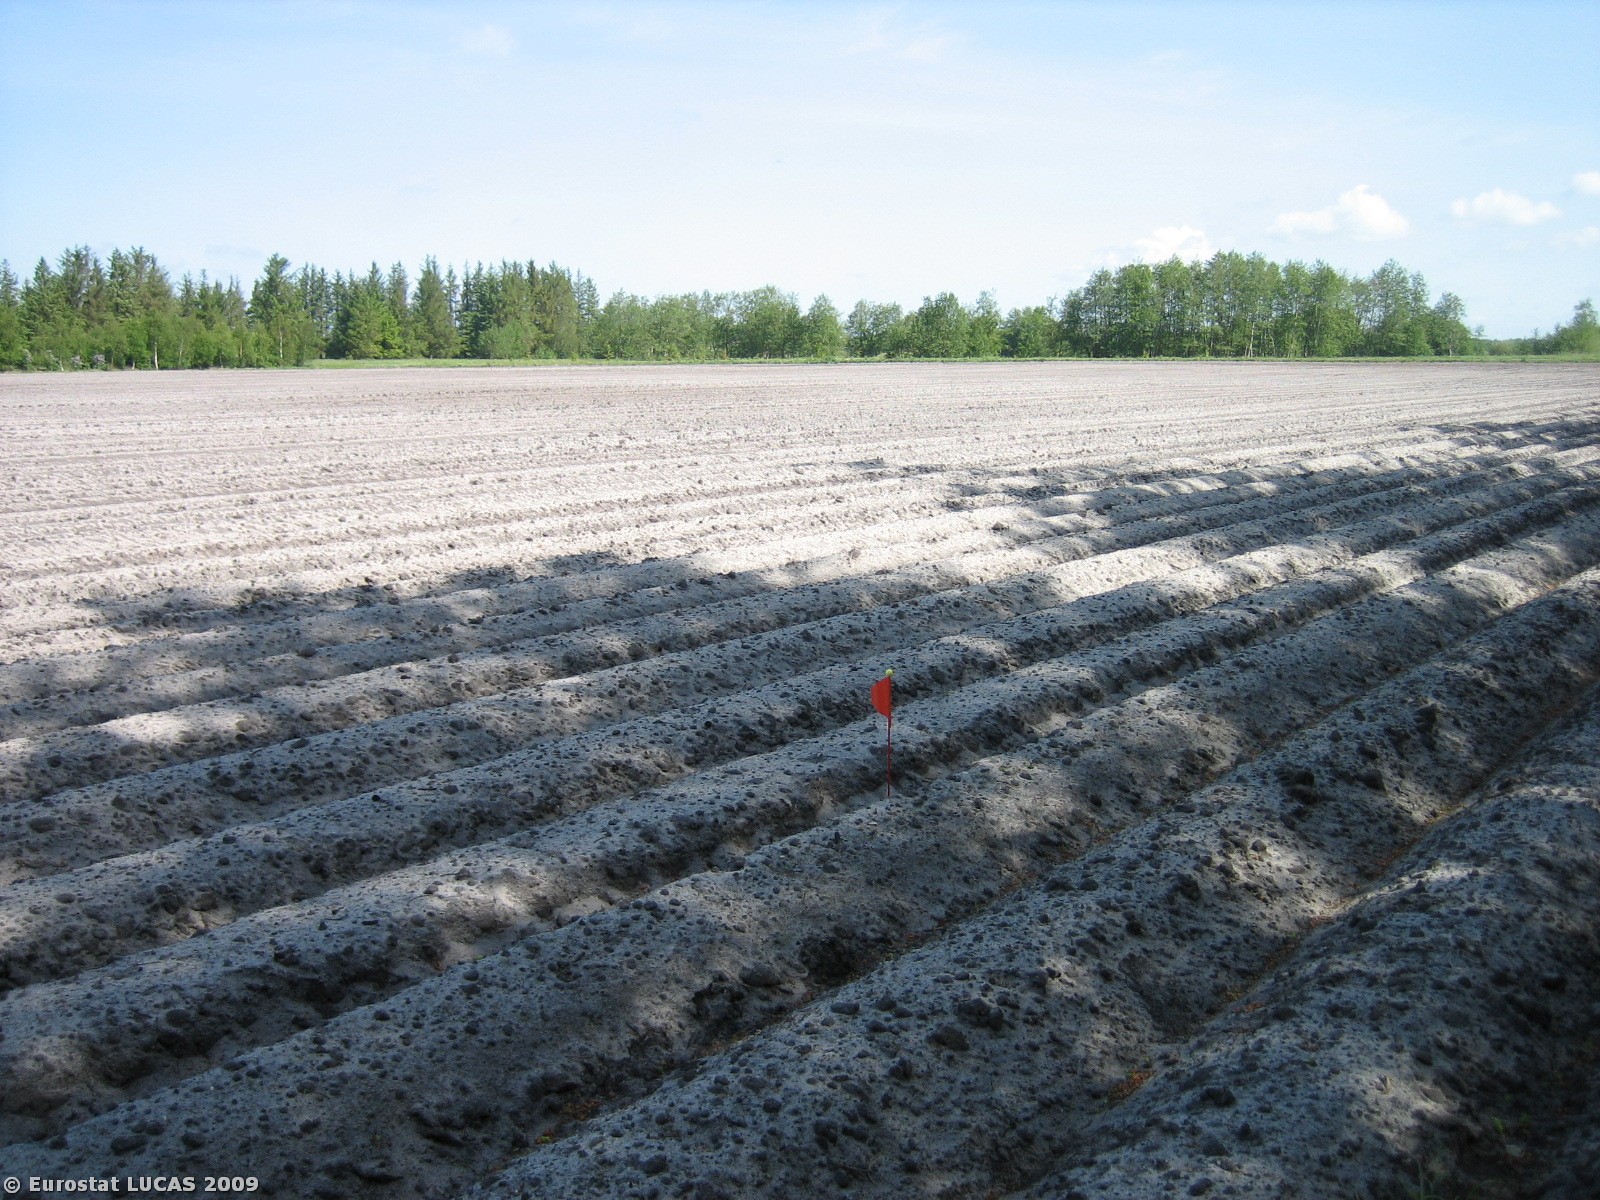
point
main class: Cropland
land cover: Potatoes
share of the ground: < 10 %
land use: Agriculture (excluding fallow land and kitchen gardens)
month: May
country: DK
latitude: 56.1851
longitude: 9.1793
